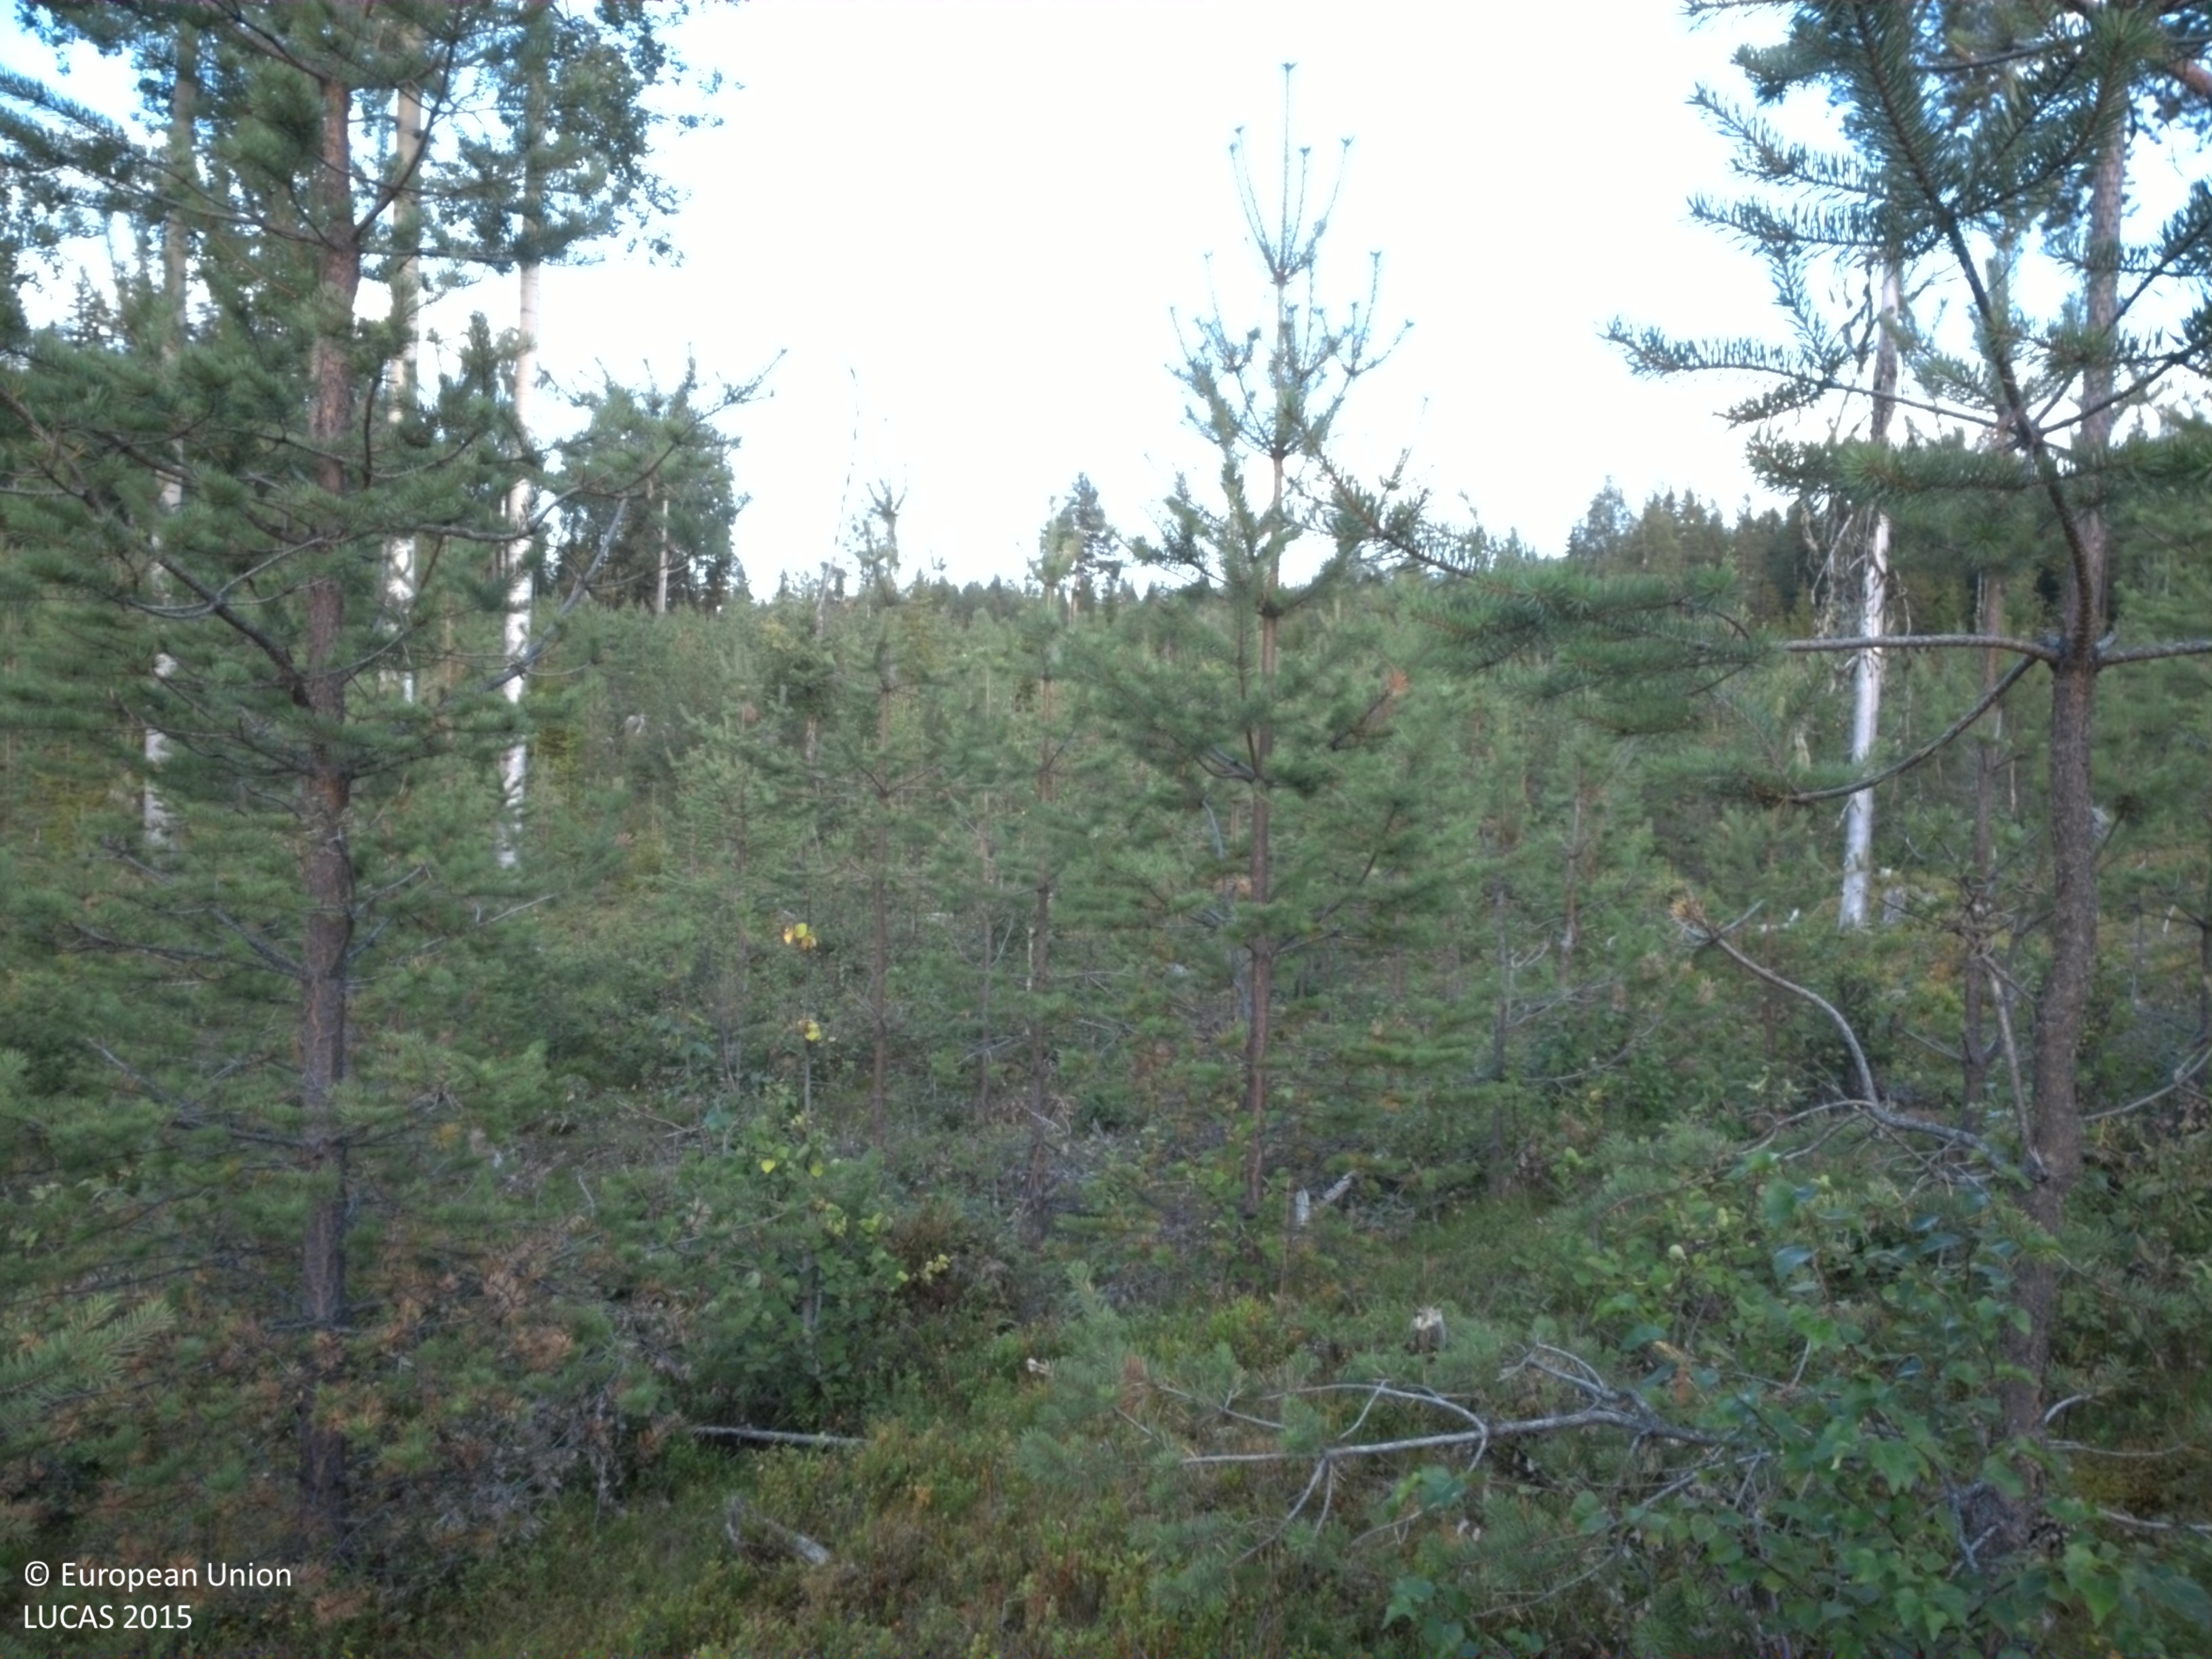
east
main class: Woodland
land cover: Pine dominated coniferous woodland
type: boreal forest
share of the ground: 25 - 50 %
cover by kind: coniferous forest trees 50 %, shrubs 40 %, lichens and mosses 10 %
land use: Forestry
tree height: < 5 m
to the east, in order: Pine dominated coniferous woodland; Pine dominated mixed woodland; Spruce dominated mixed woodland; Pine dominated mixed woodland; Broadleaved woodland; Other mixed woodland
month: August
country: SE
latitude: 64.3888
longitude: 18.8236
